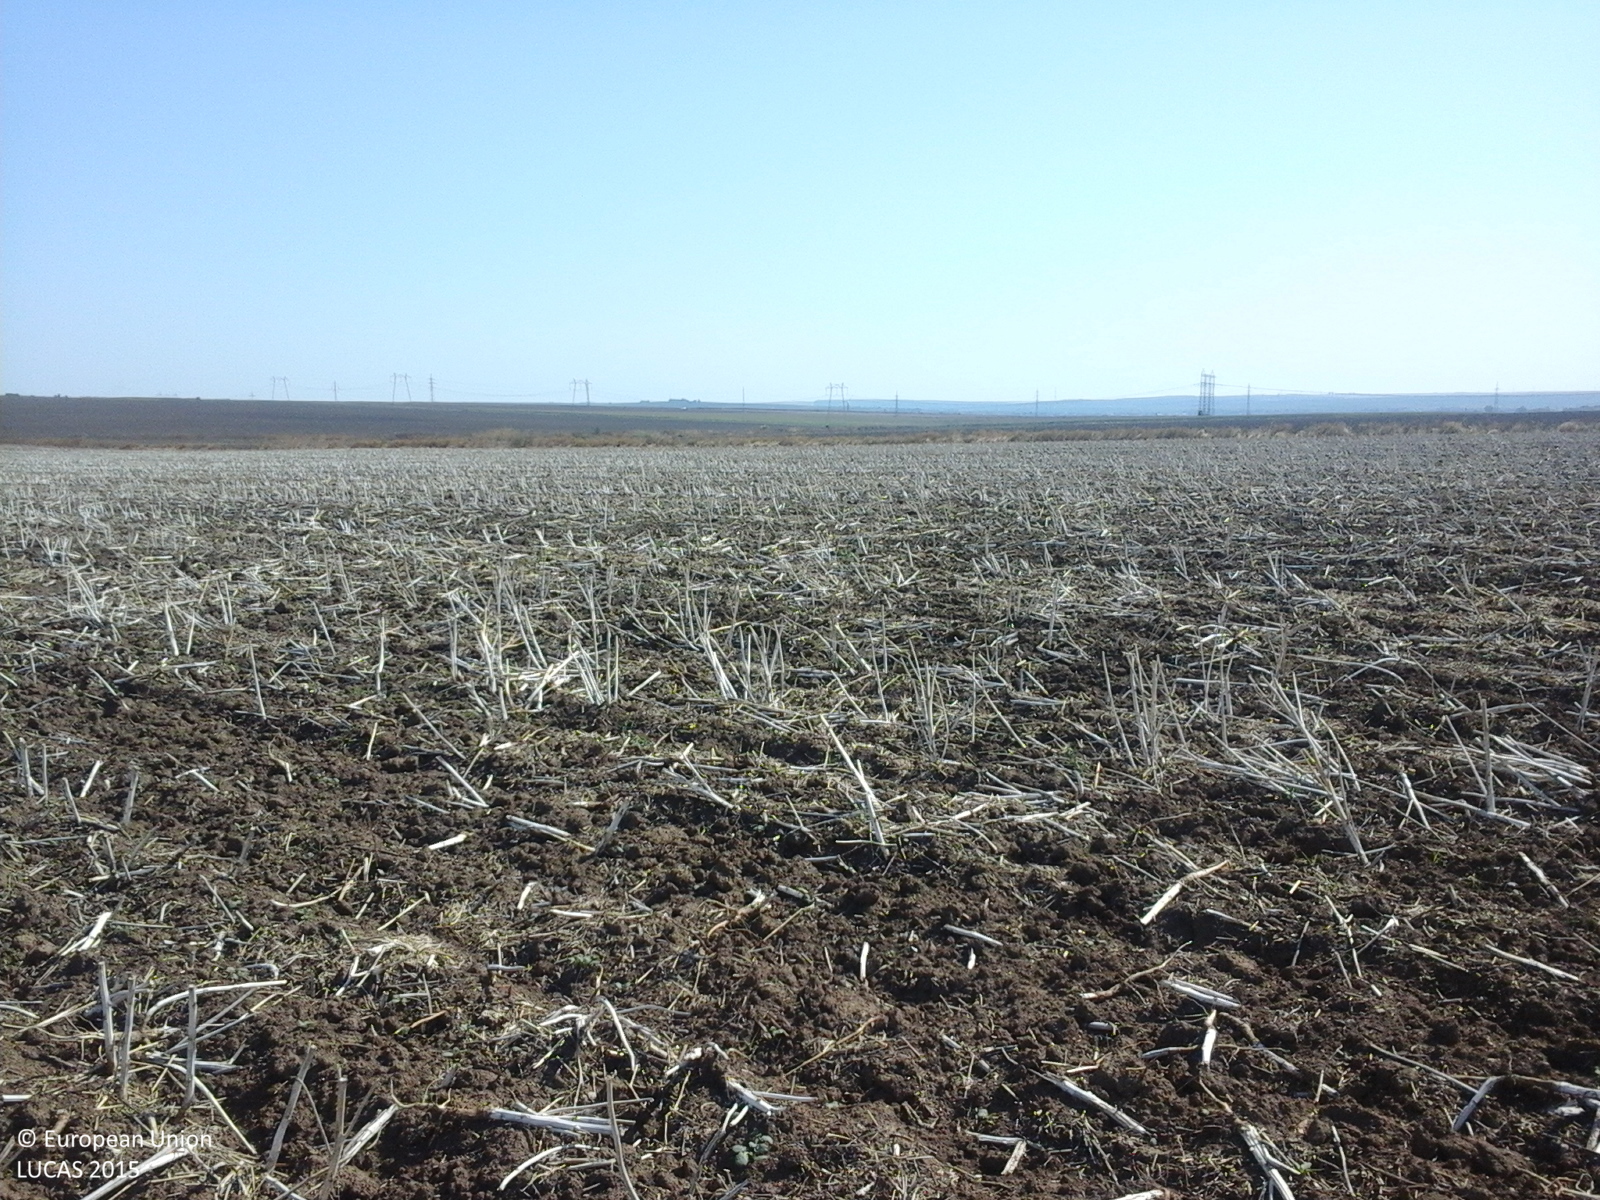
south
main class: Cropland
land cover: Rape and turnip rape
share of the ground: 10 - 25 %
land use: Agriculture (excluding fallow land and kitchen gardens)
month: August
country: RO
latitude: 44.2540
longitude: 28.4161
